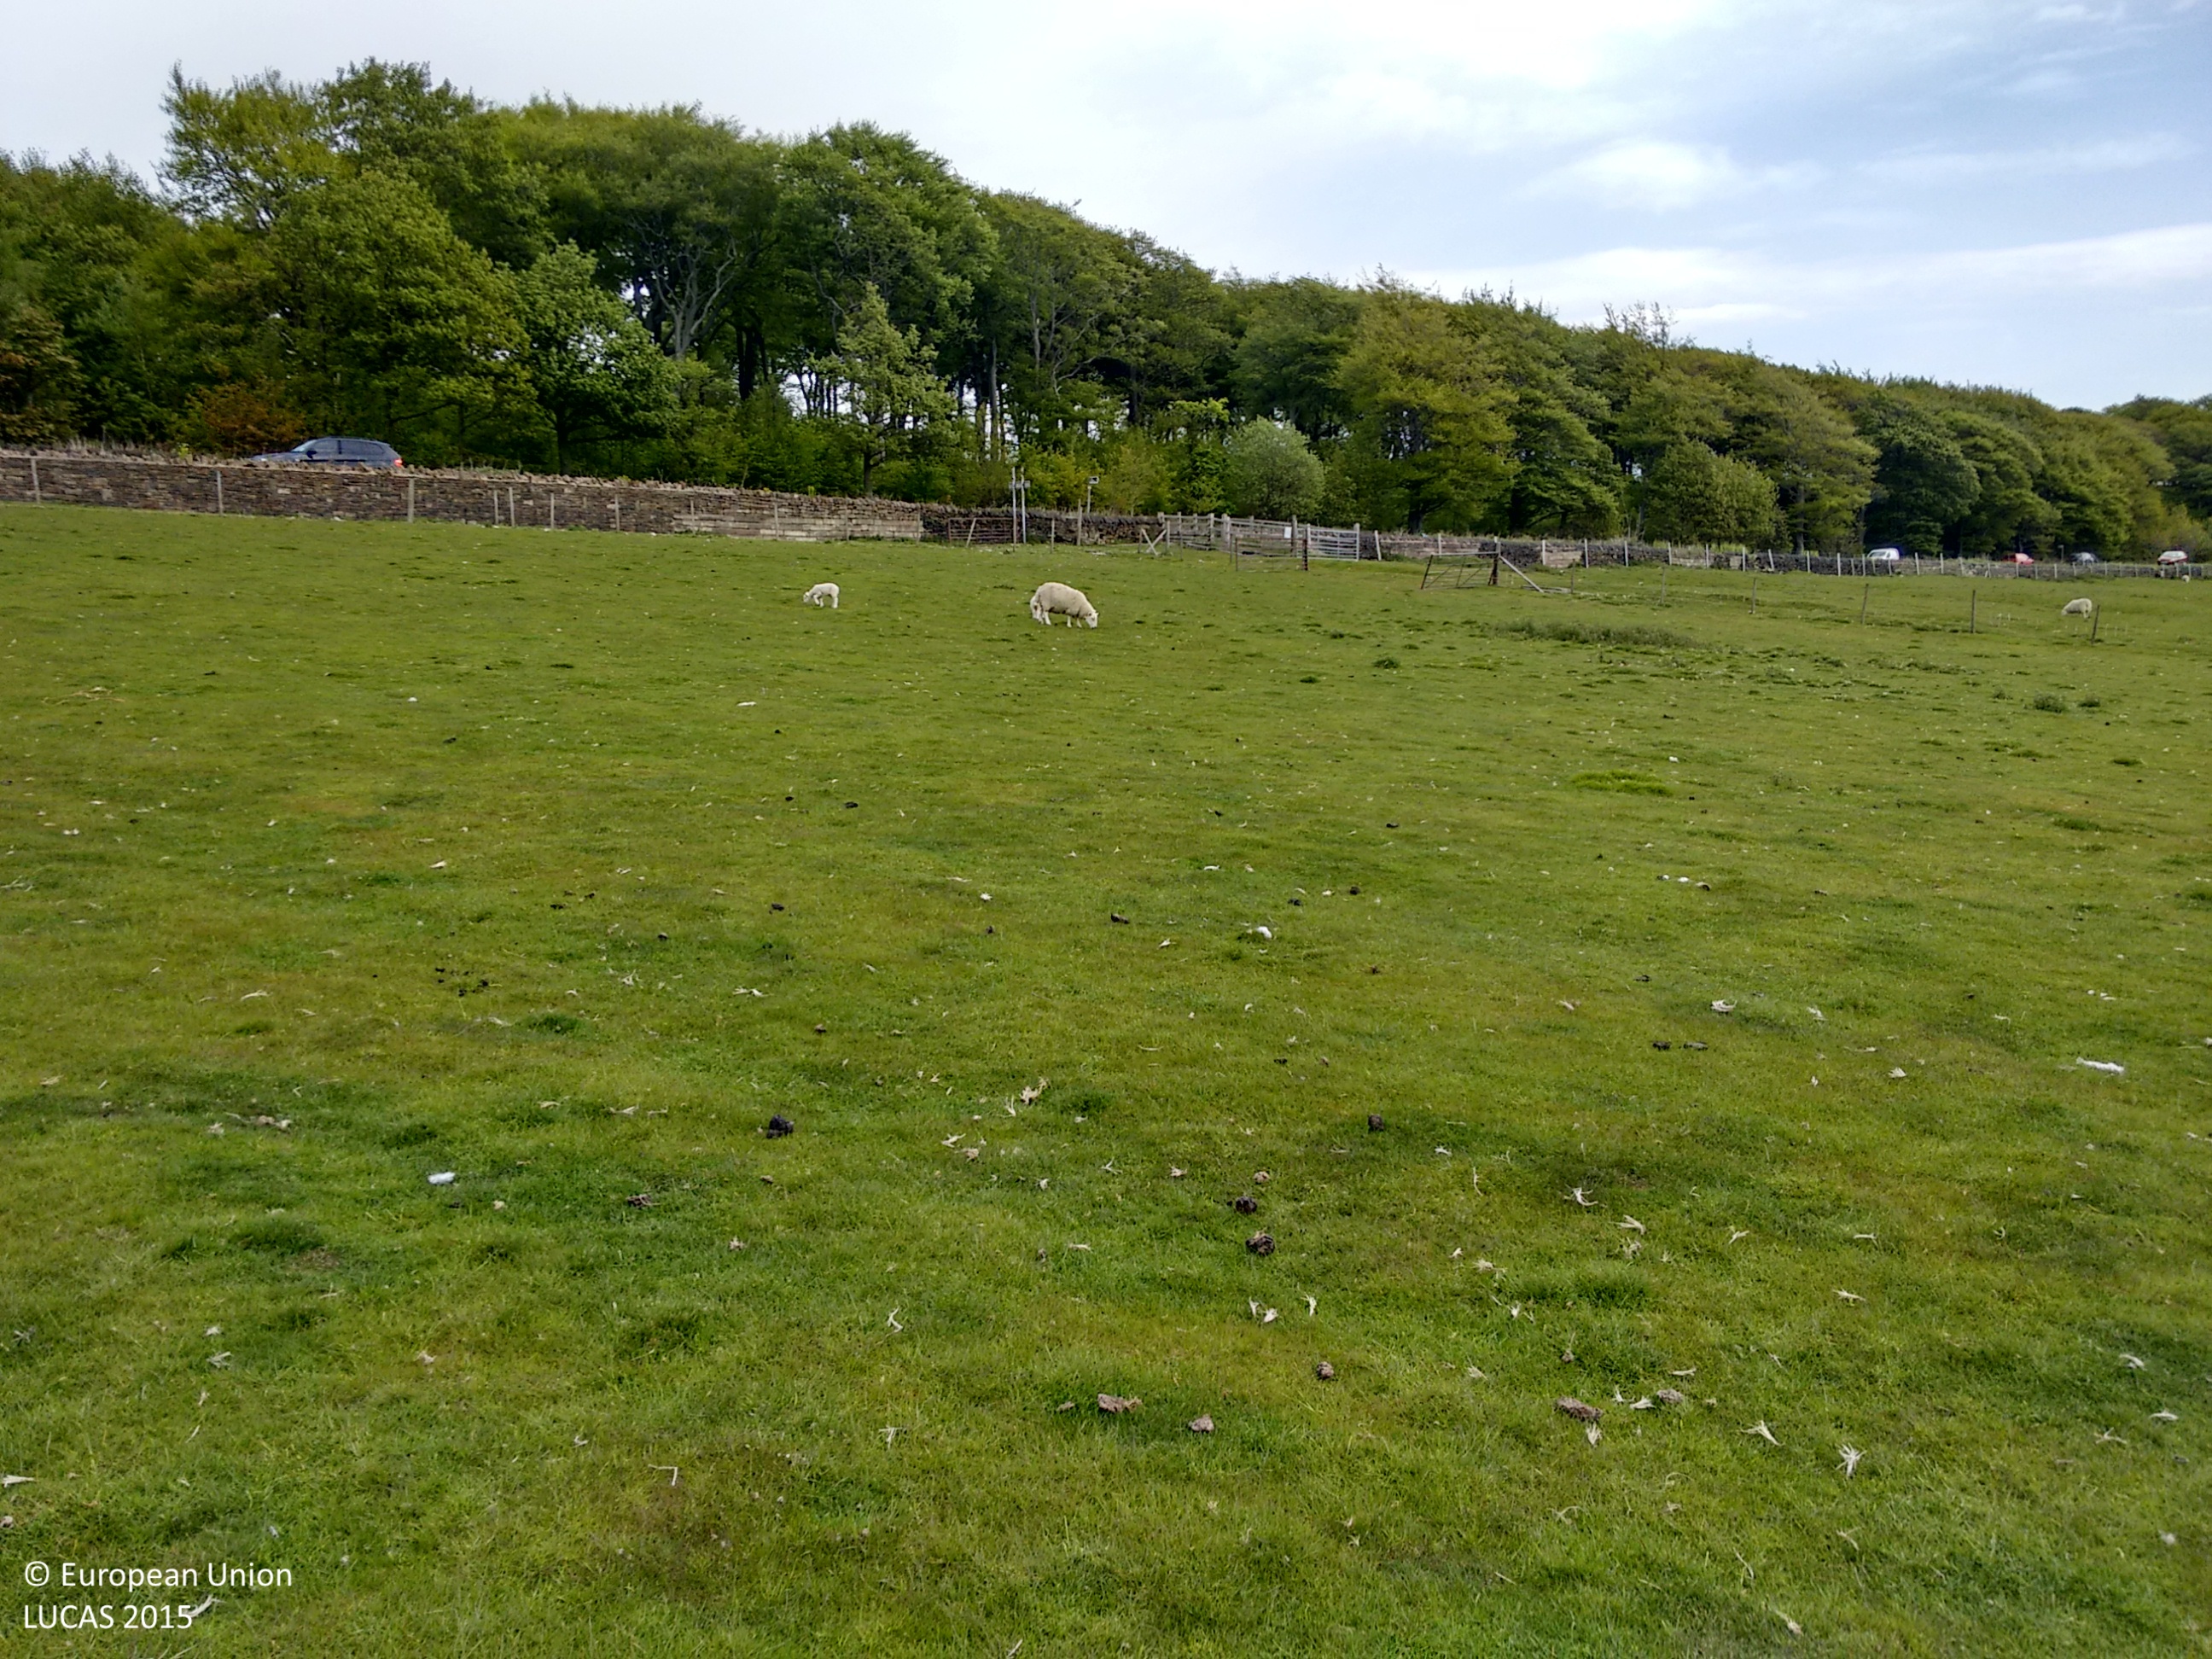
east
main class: Grassland
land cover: Grassland without tree/shrub cover
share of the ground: > 75 %
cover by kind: herbaceous plants 100 %
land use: Agriculture (excluding fallow land and kitchen gardens)
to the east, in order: Grassland without tree/shrub cover; Fences; Grassland without tree/shrub cover; Dry stone walls; Grass margins; Paved roads, cycling and walking lanes; Grass margins; Broadleaved woodland
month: May
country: GB
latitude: 53.5009
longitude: -1.5537
